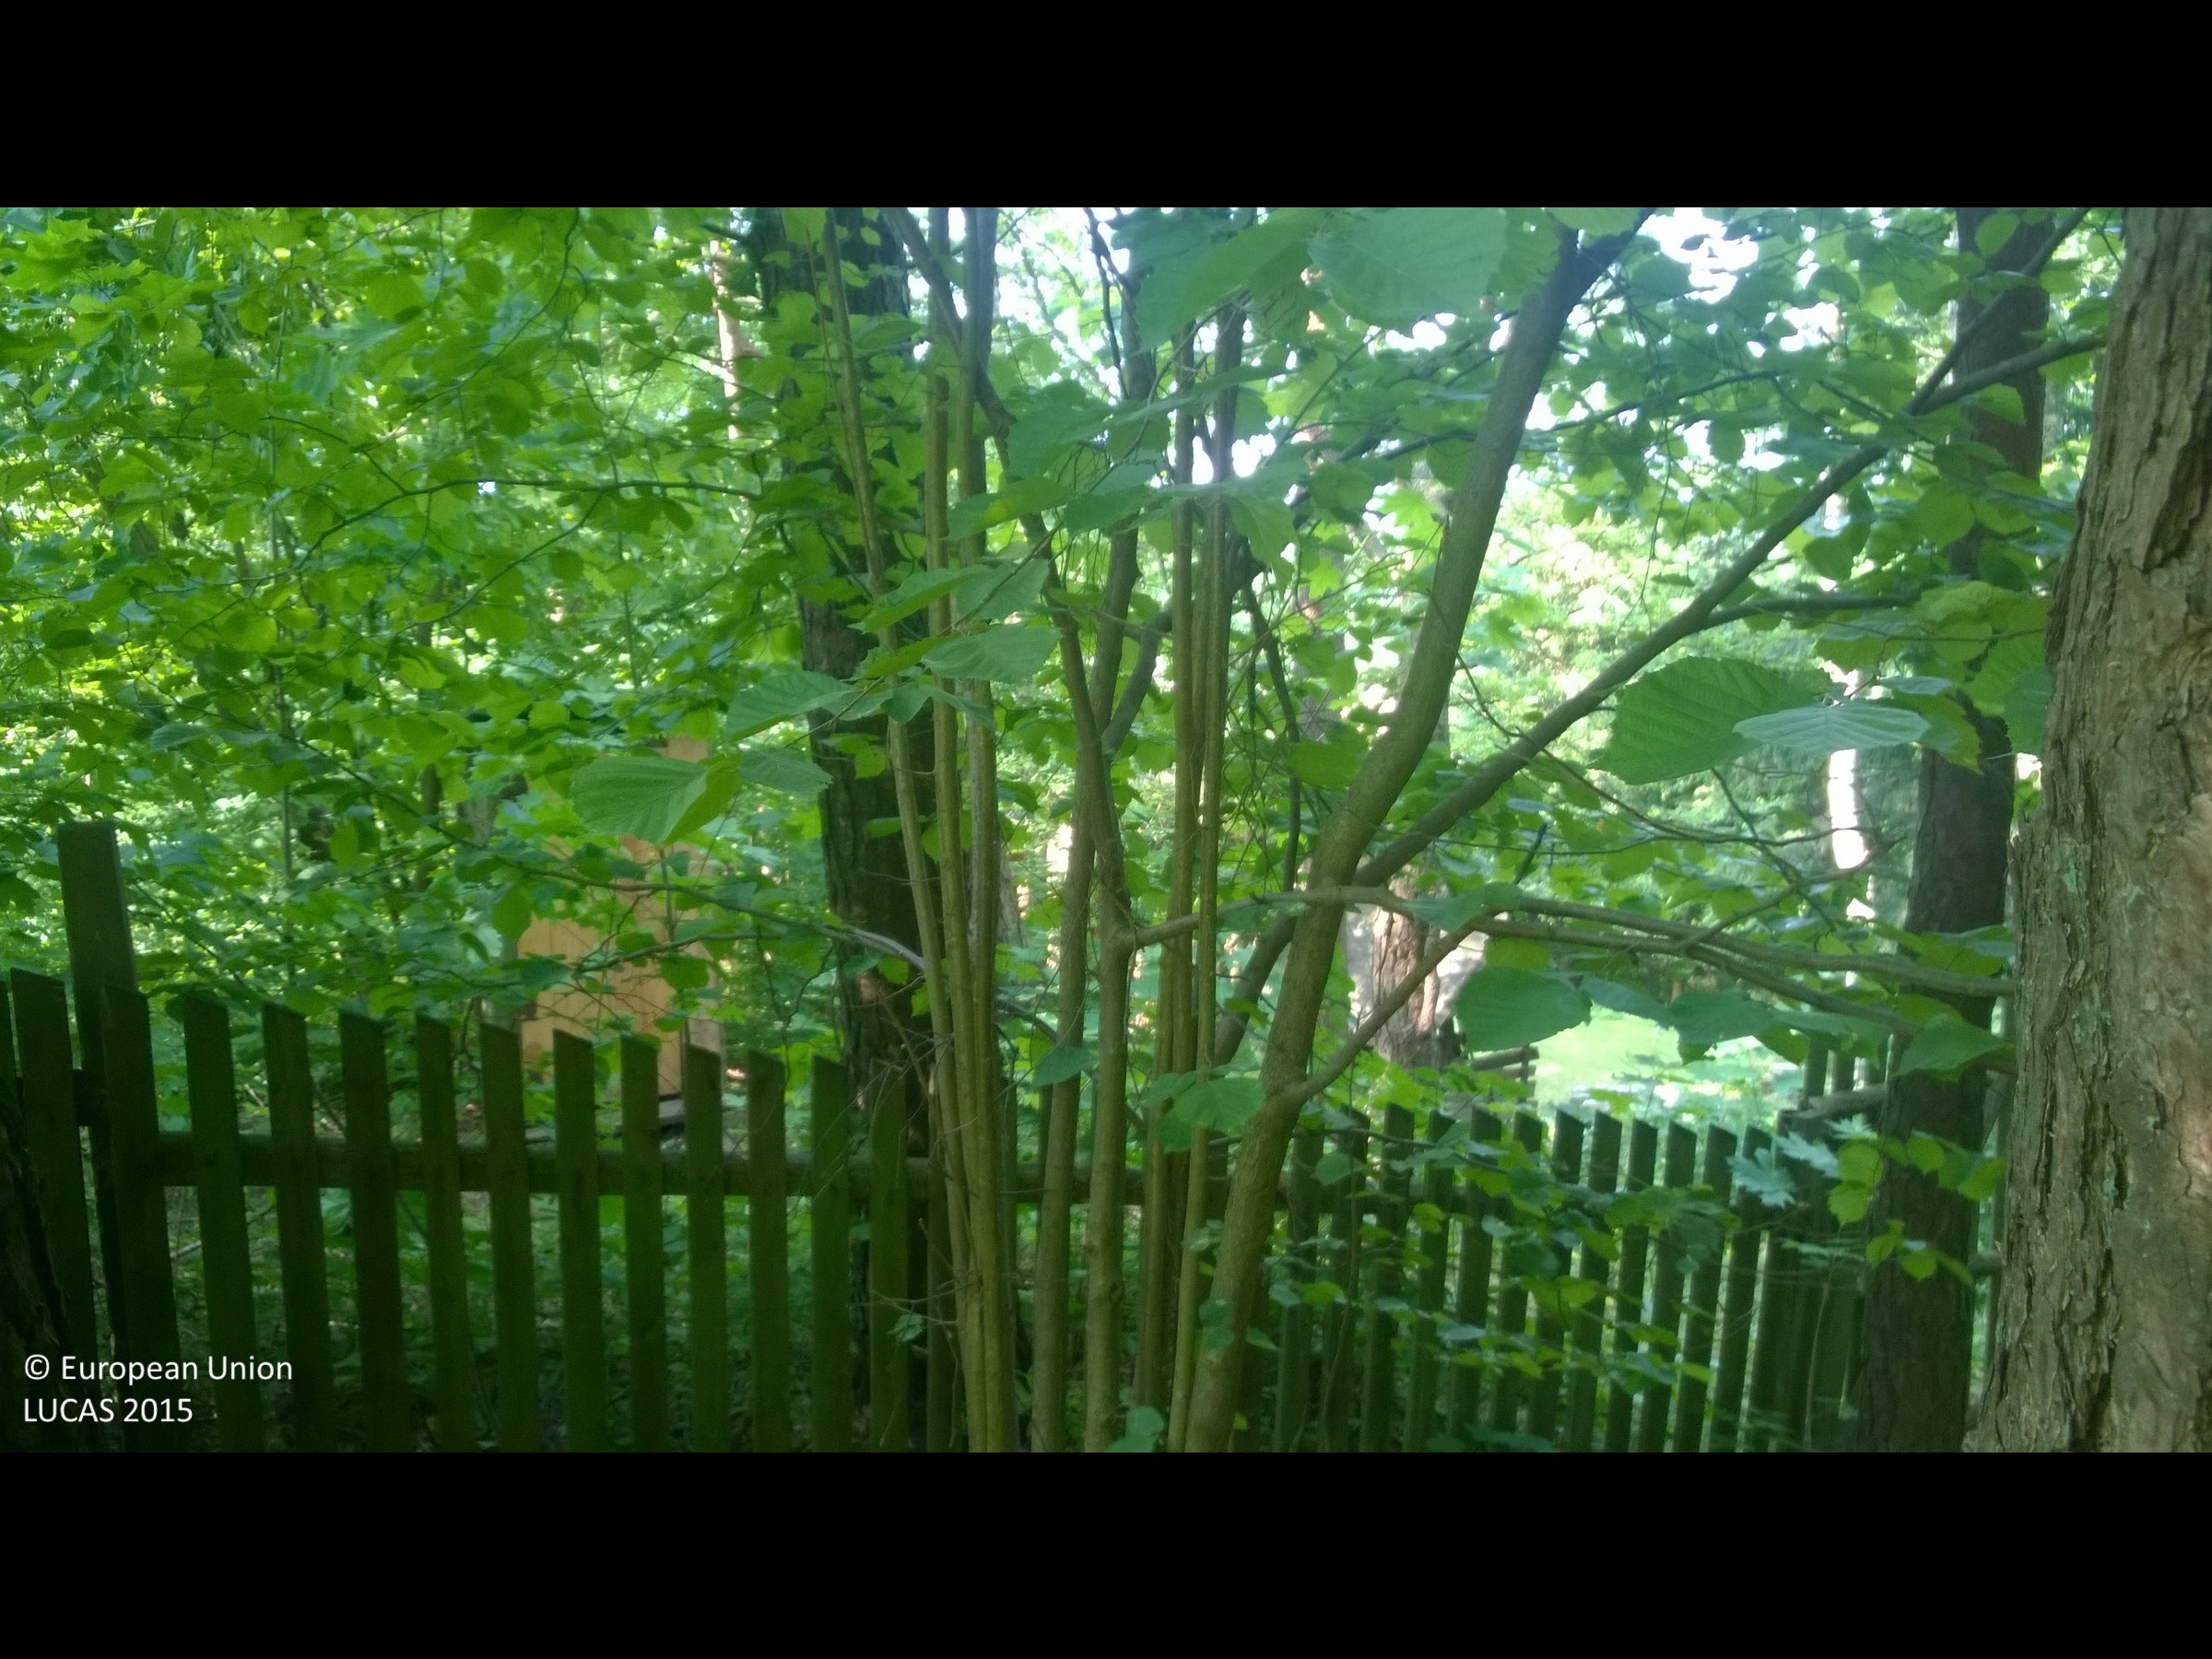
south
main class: Woodland
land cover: Pine dominated mixed woodland
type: hemiboreal forest and nemoral coniferous forest and mixed broadleaved-coniferous forest
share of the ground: > 75 %
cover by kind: coniferous forest trees 50 %, broadleaved forest trees 35 %, shrubs 10 %, herbaceous plants 5 %
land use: Forestry
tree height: > 5 m
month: June
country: PL
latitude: 53.1096
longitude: 23.3921
